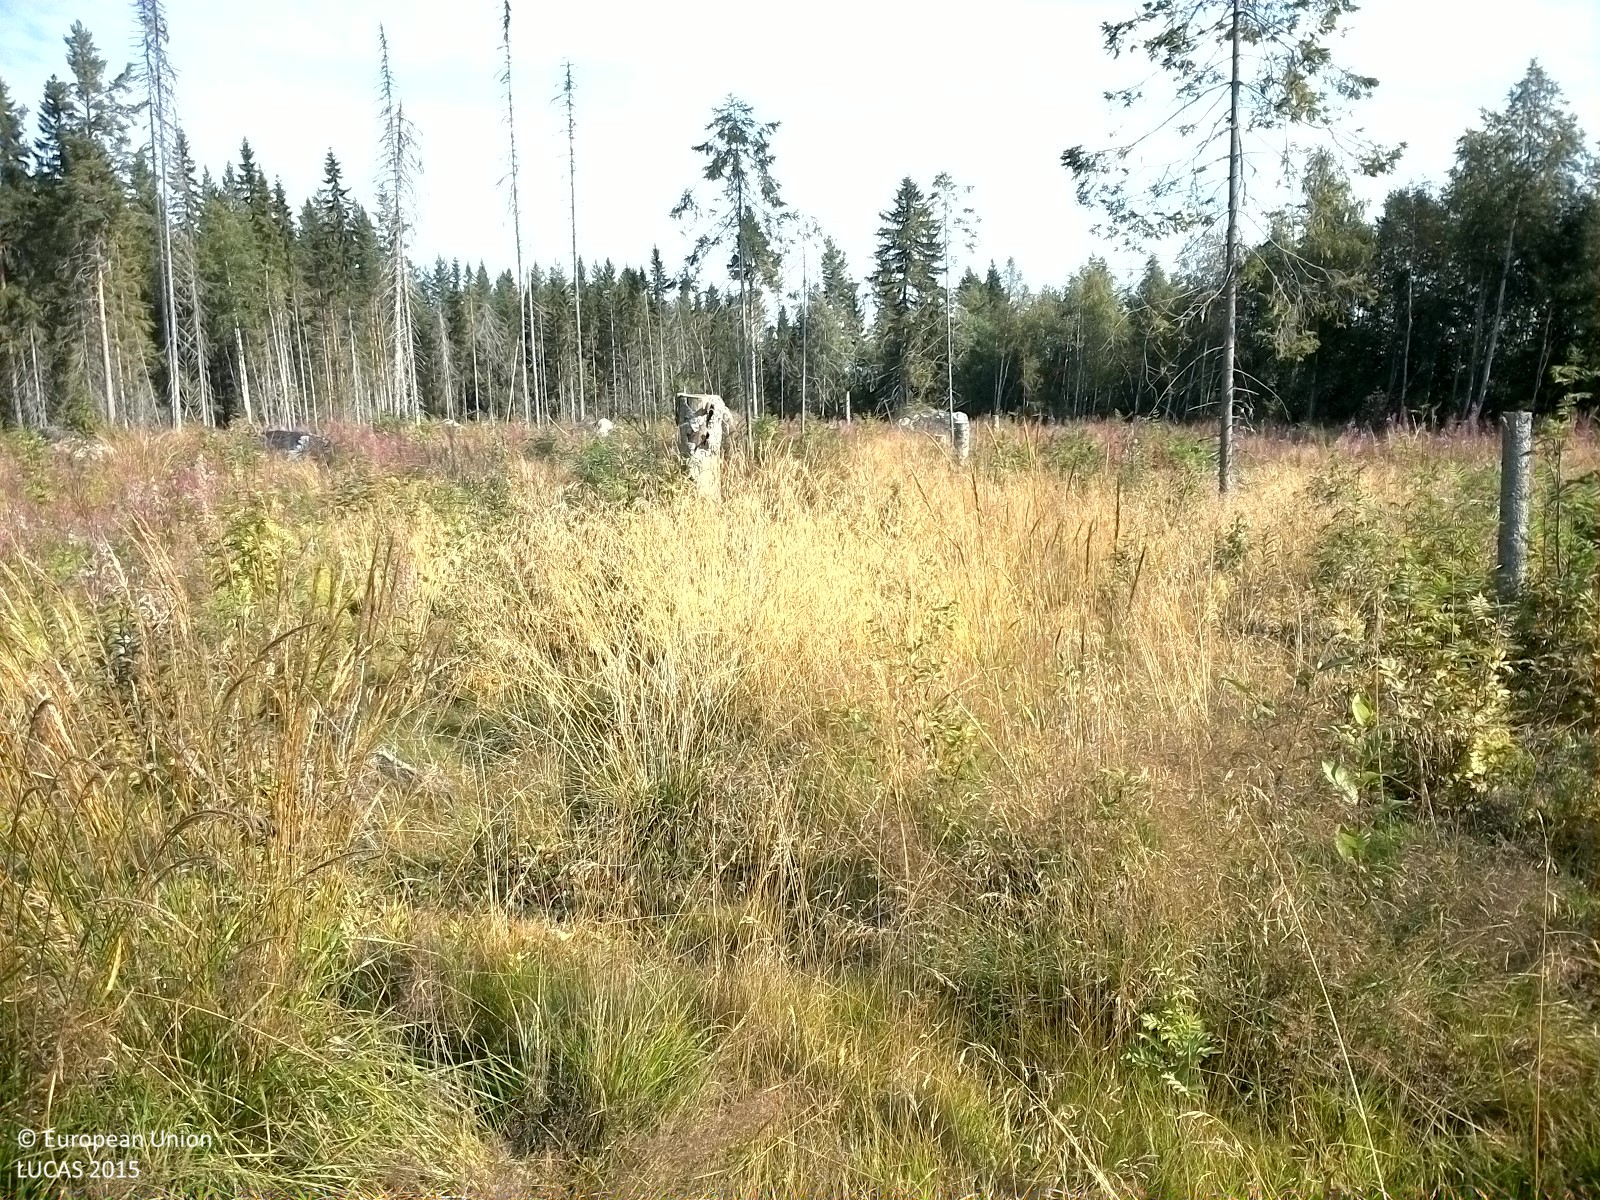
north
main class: Woodland
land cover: Spruce dominated mixed woodland
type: boreal forest
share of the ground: 10 - 25 %
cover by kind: herbaceous plants 50 %, shrubs 30 %, coniferous forest trees 10 %, broadleaved forest trees 10 %
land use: Forestry
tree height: < 5 m
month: August
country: SE
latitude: 62.4616
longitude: 16.3191
